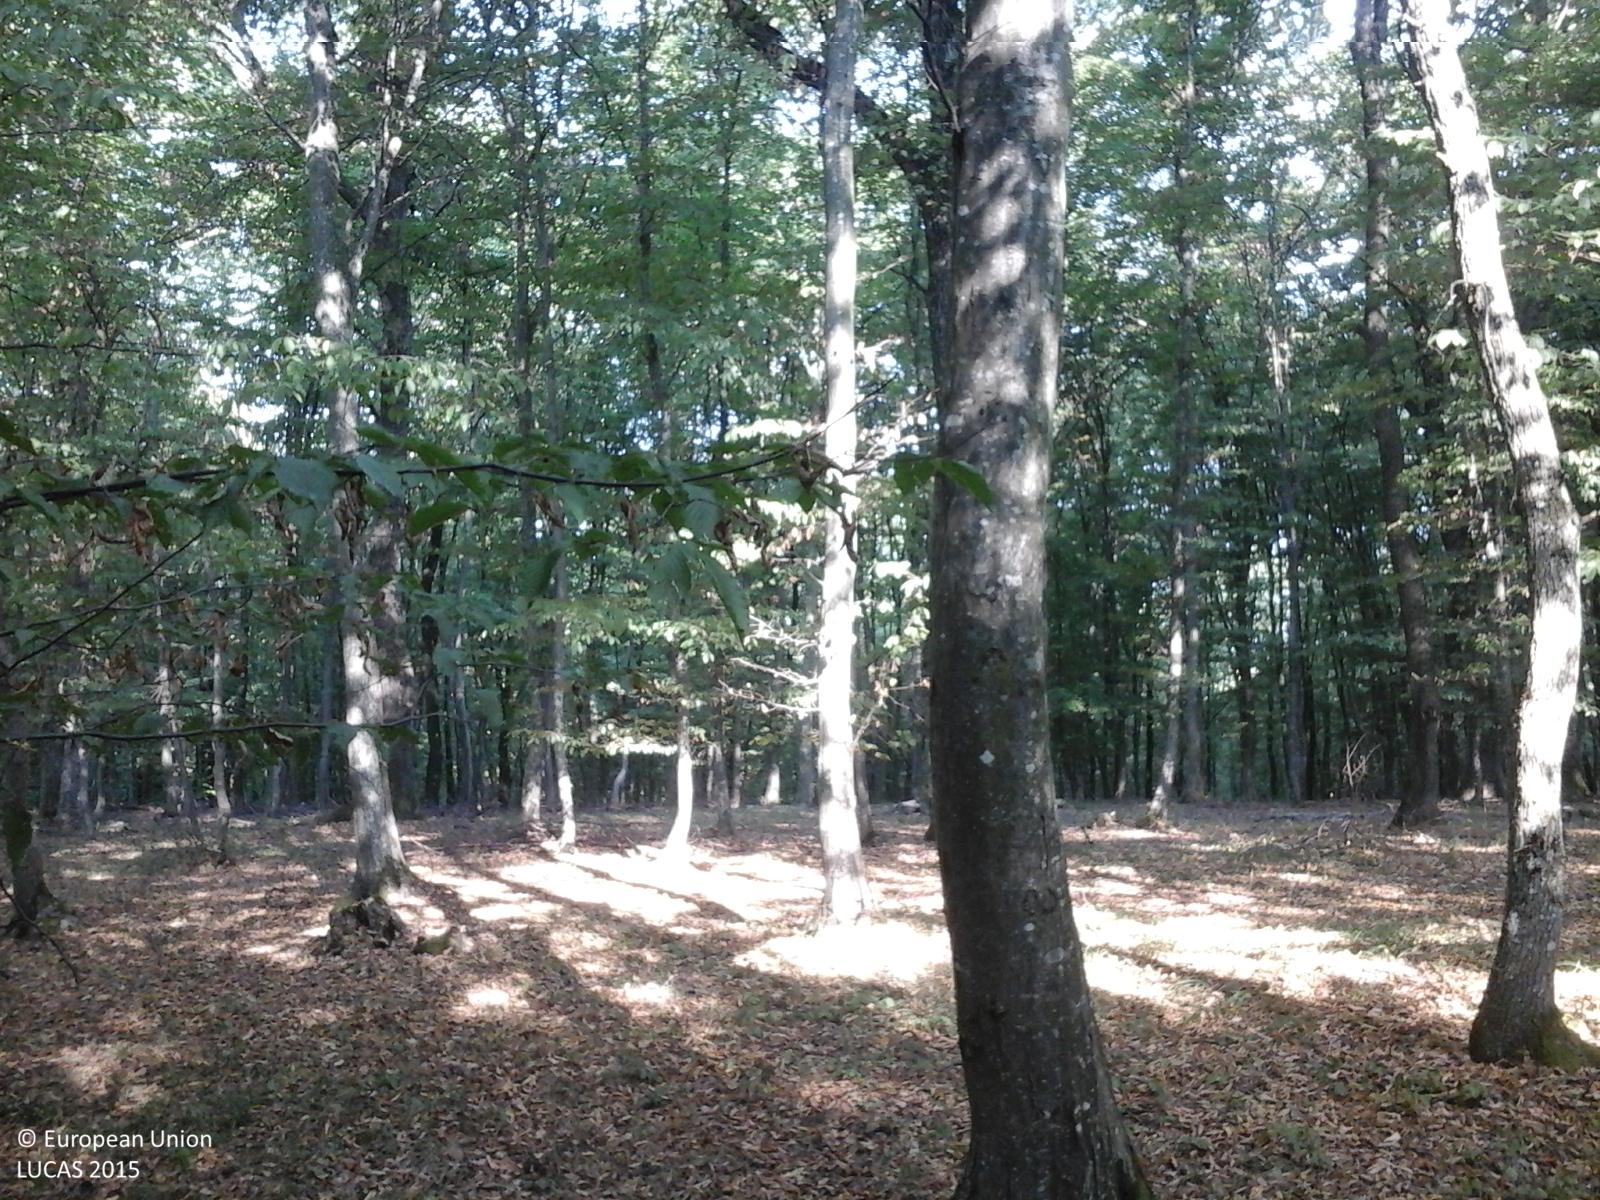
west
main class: Woodland
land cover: Broadleaved woodland
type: beech forest
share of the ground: > 75 %
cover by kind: broadleaved forest trees 100 %
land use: Forestry
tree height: > 5 m
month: September
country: RO
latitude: 46.8803
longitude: 24.4570
